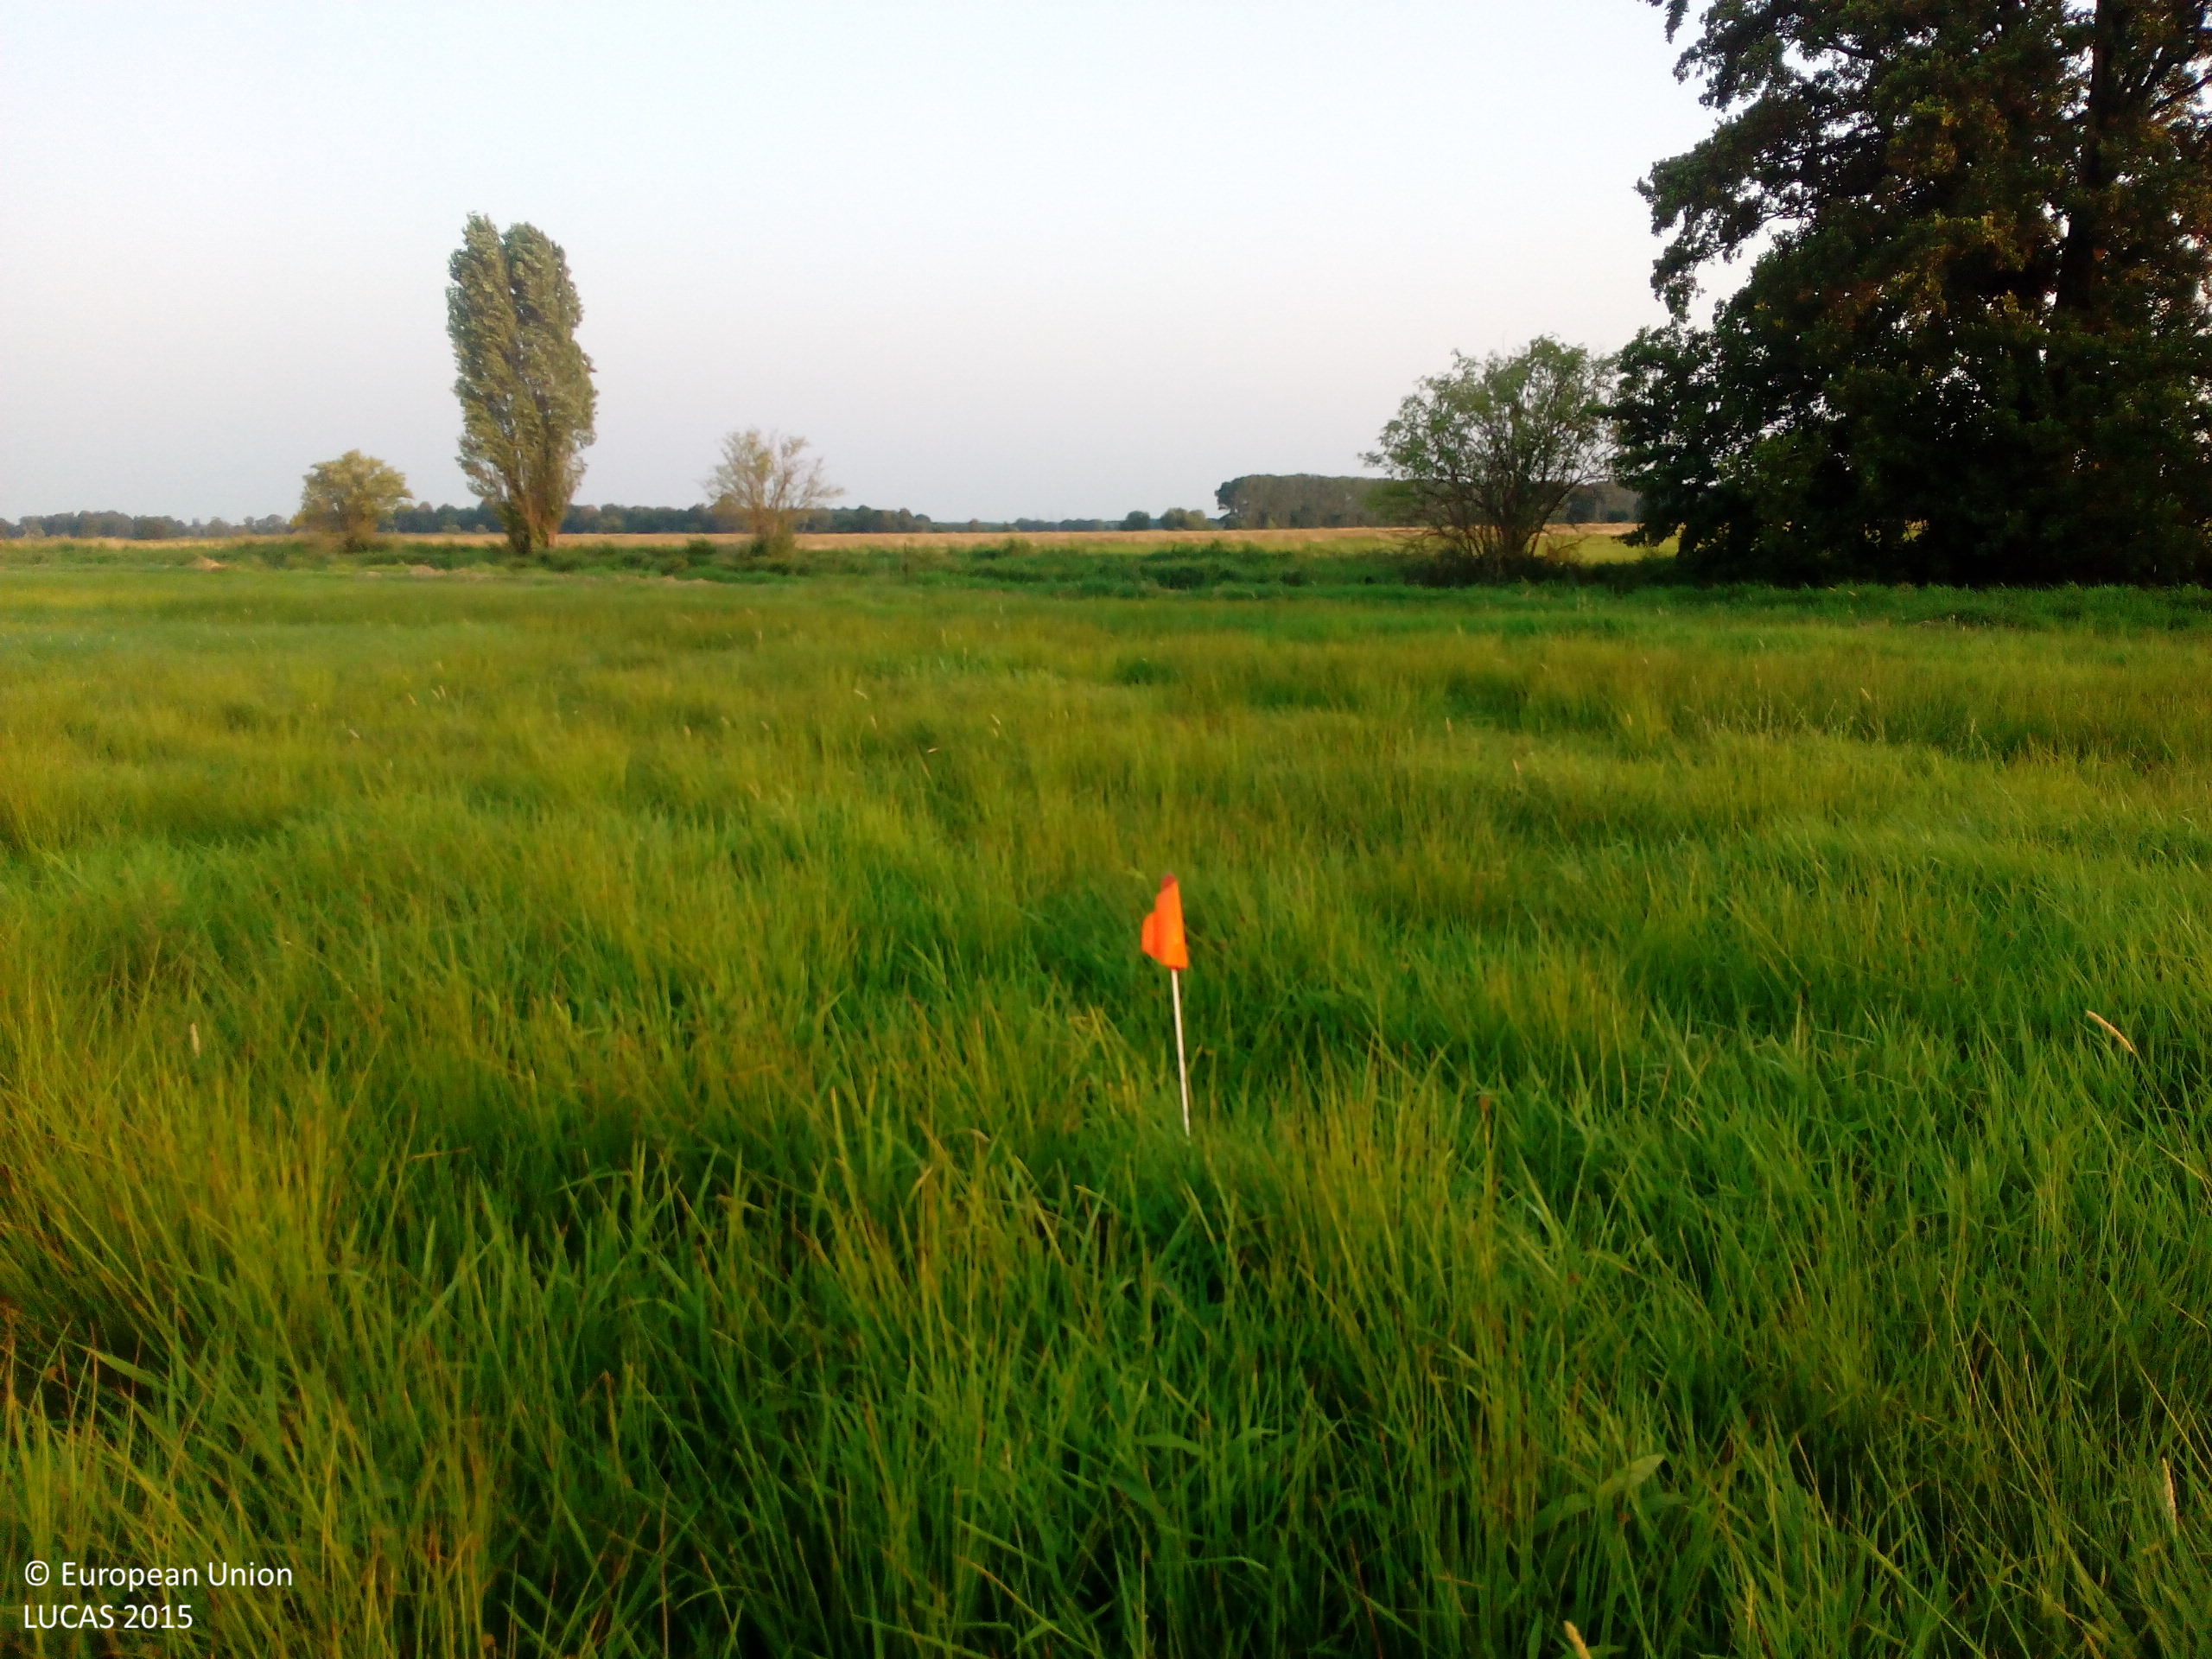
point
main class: Grassland
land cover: Grassland without tree/shrub cover
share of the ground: > 75 %
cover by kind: herbaceous plants 100 %
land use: Agriculture (excluding fallow land and kitchen gardens)
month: August
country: DE
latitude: 51.8470
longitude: 14.3709
